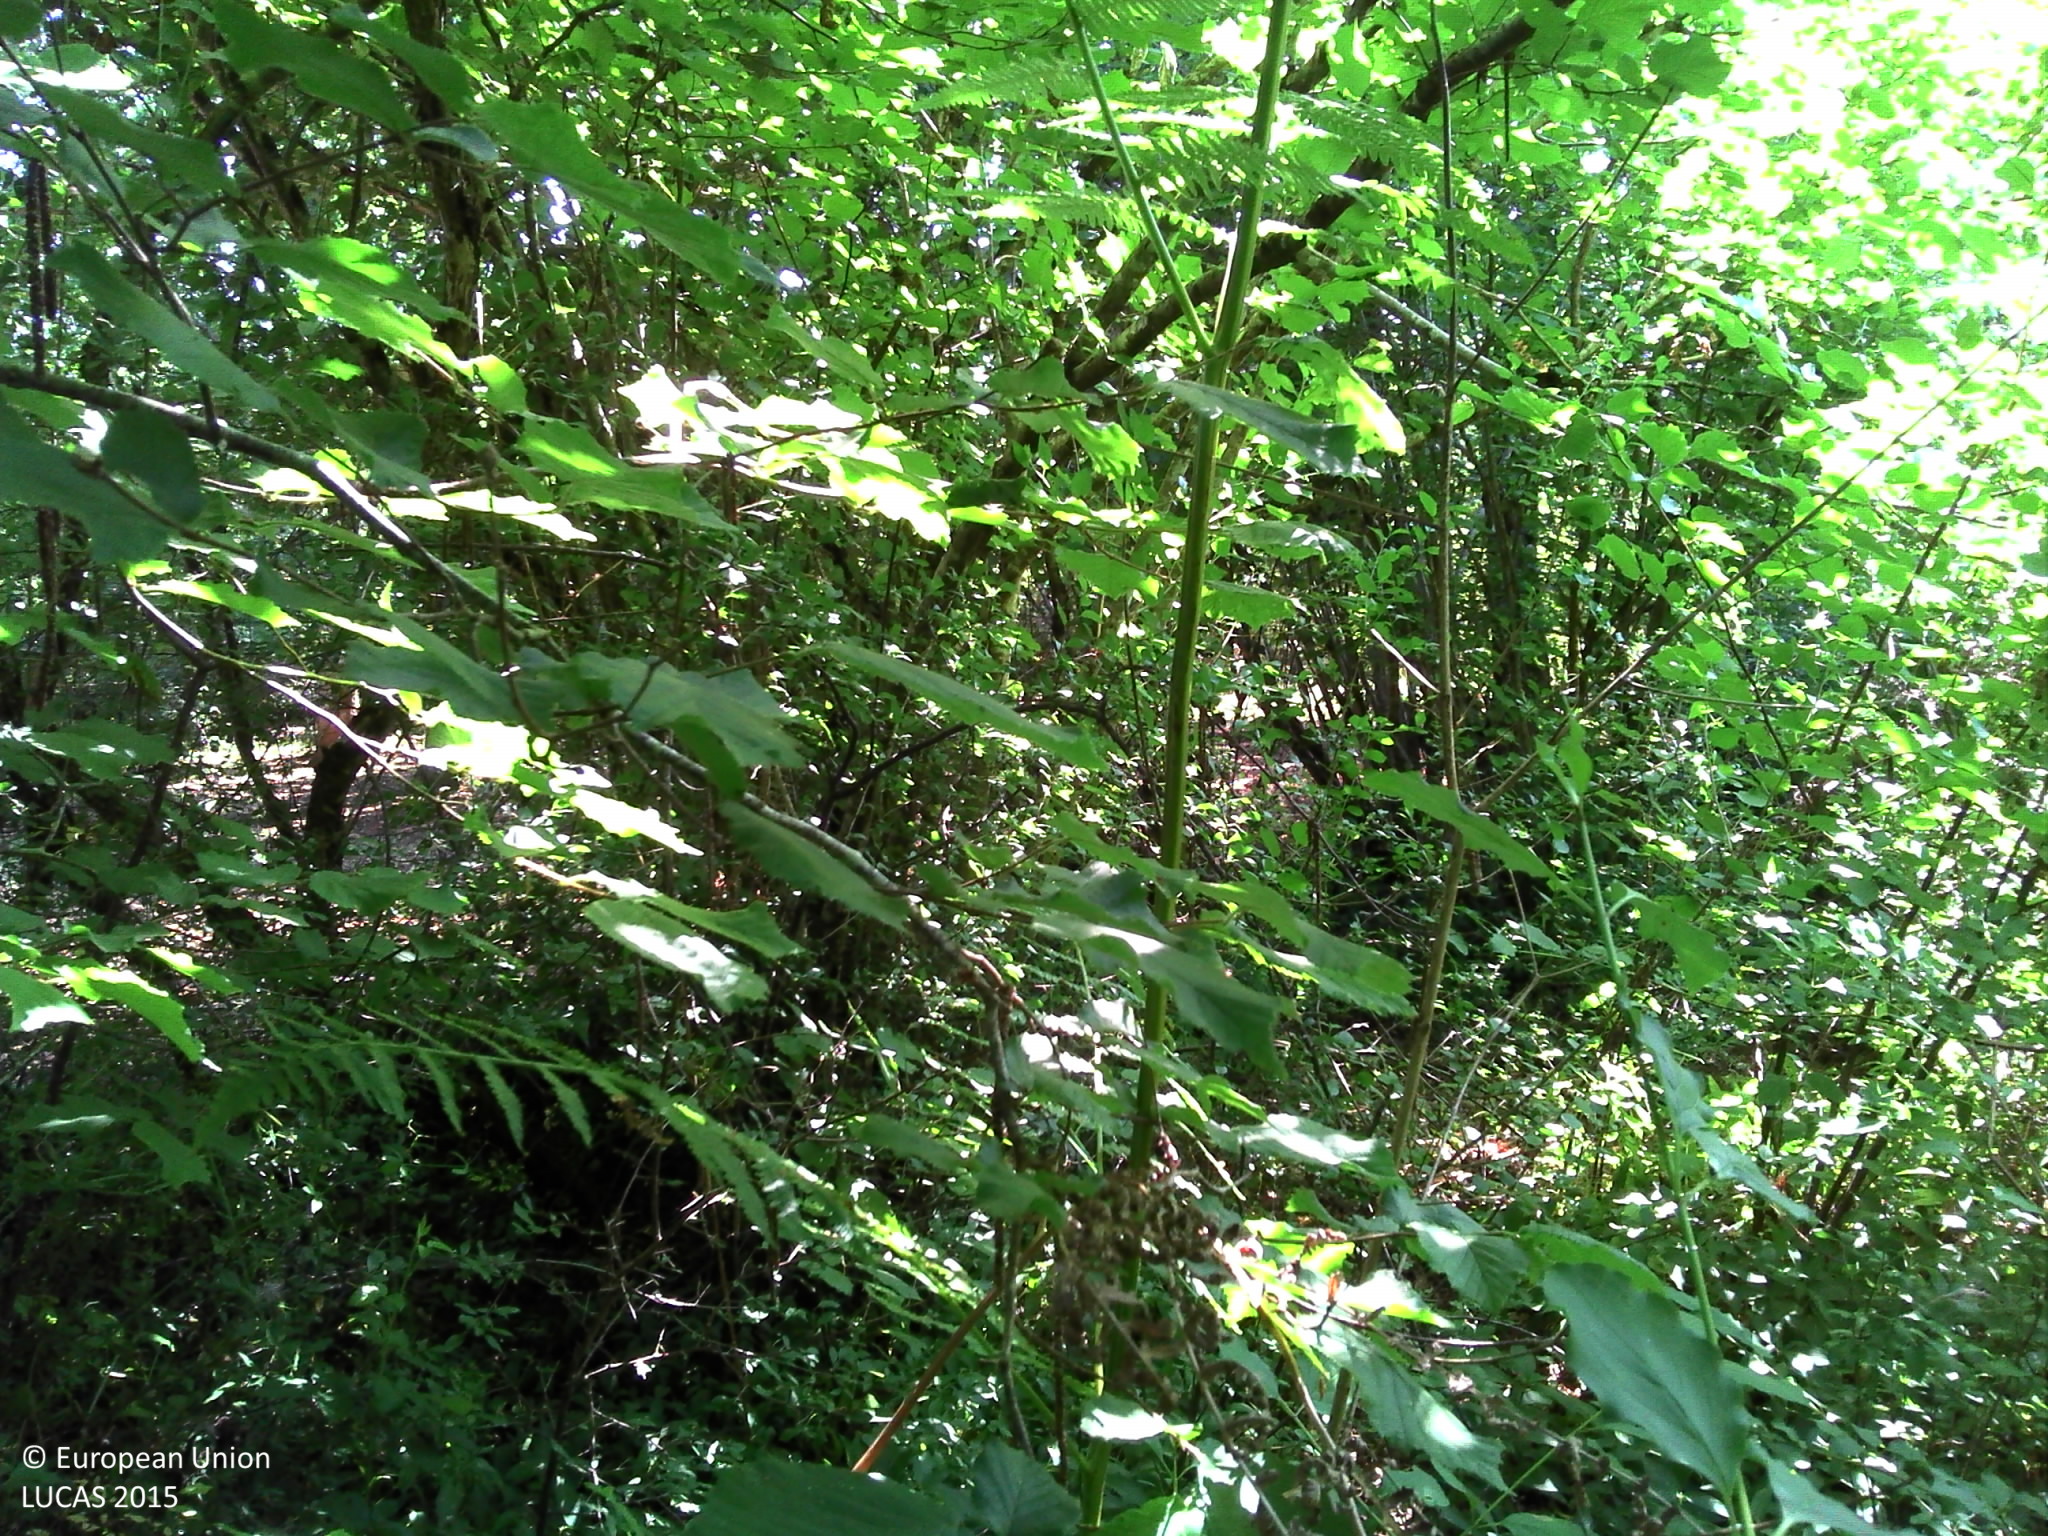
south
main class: Woodland
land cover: Broadleaved woodland
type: mesophytic deciduous forest
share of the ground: > 75 %
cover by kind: broadleaved forest trees 80 %, herbaceous plants 15 %, shrubs 5 %
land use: Forestry
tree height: > 5 m
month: June
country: FR
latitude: 45.6085
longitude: 0.3817
